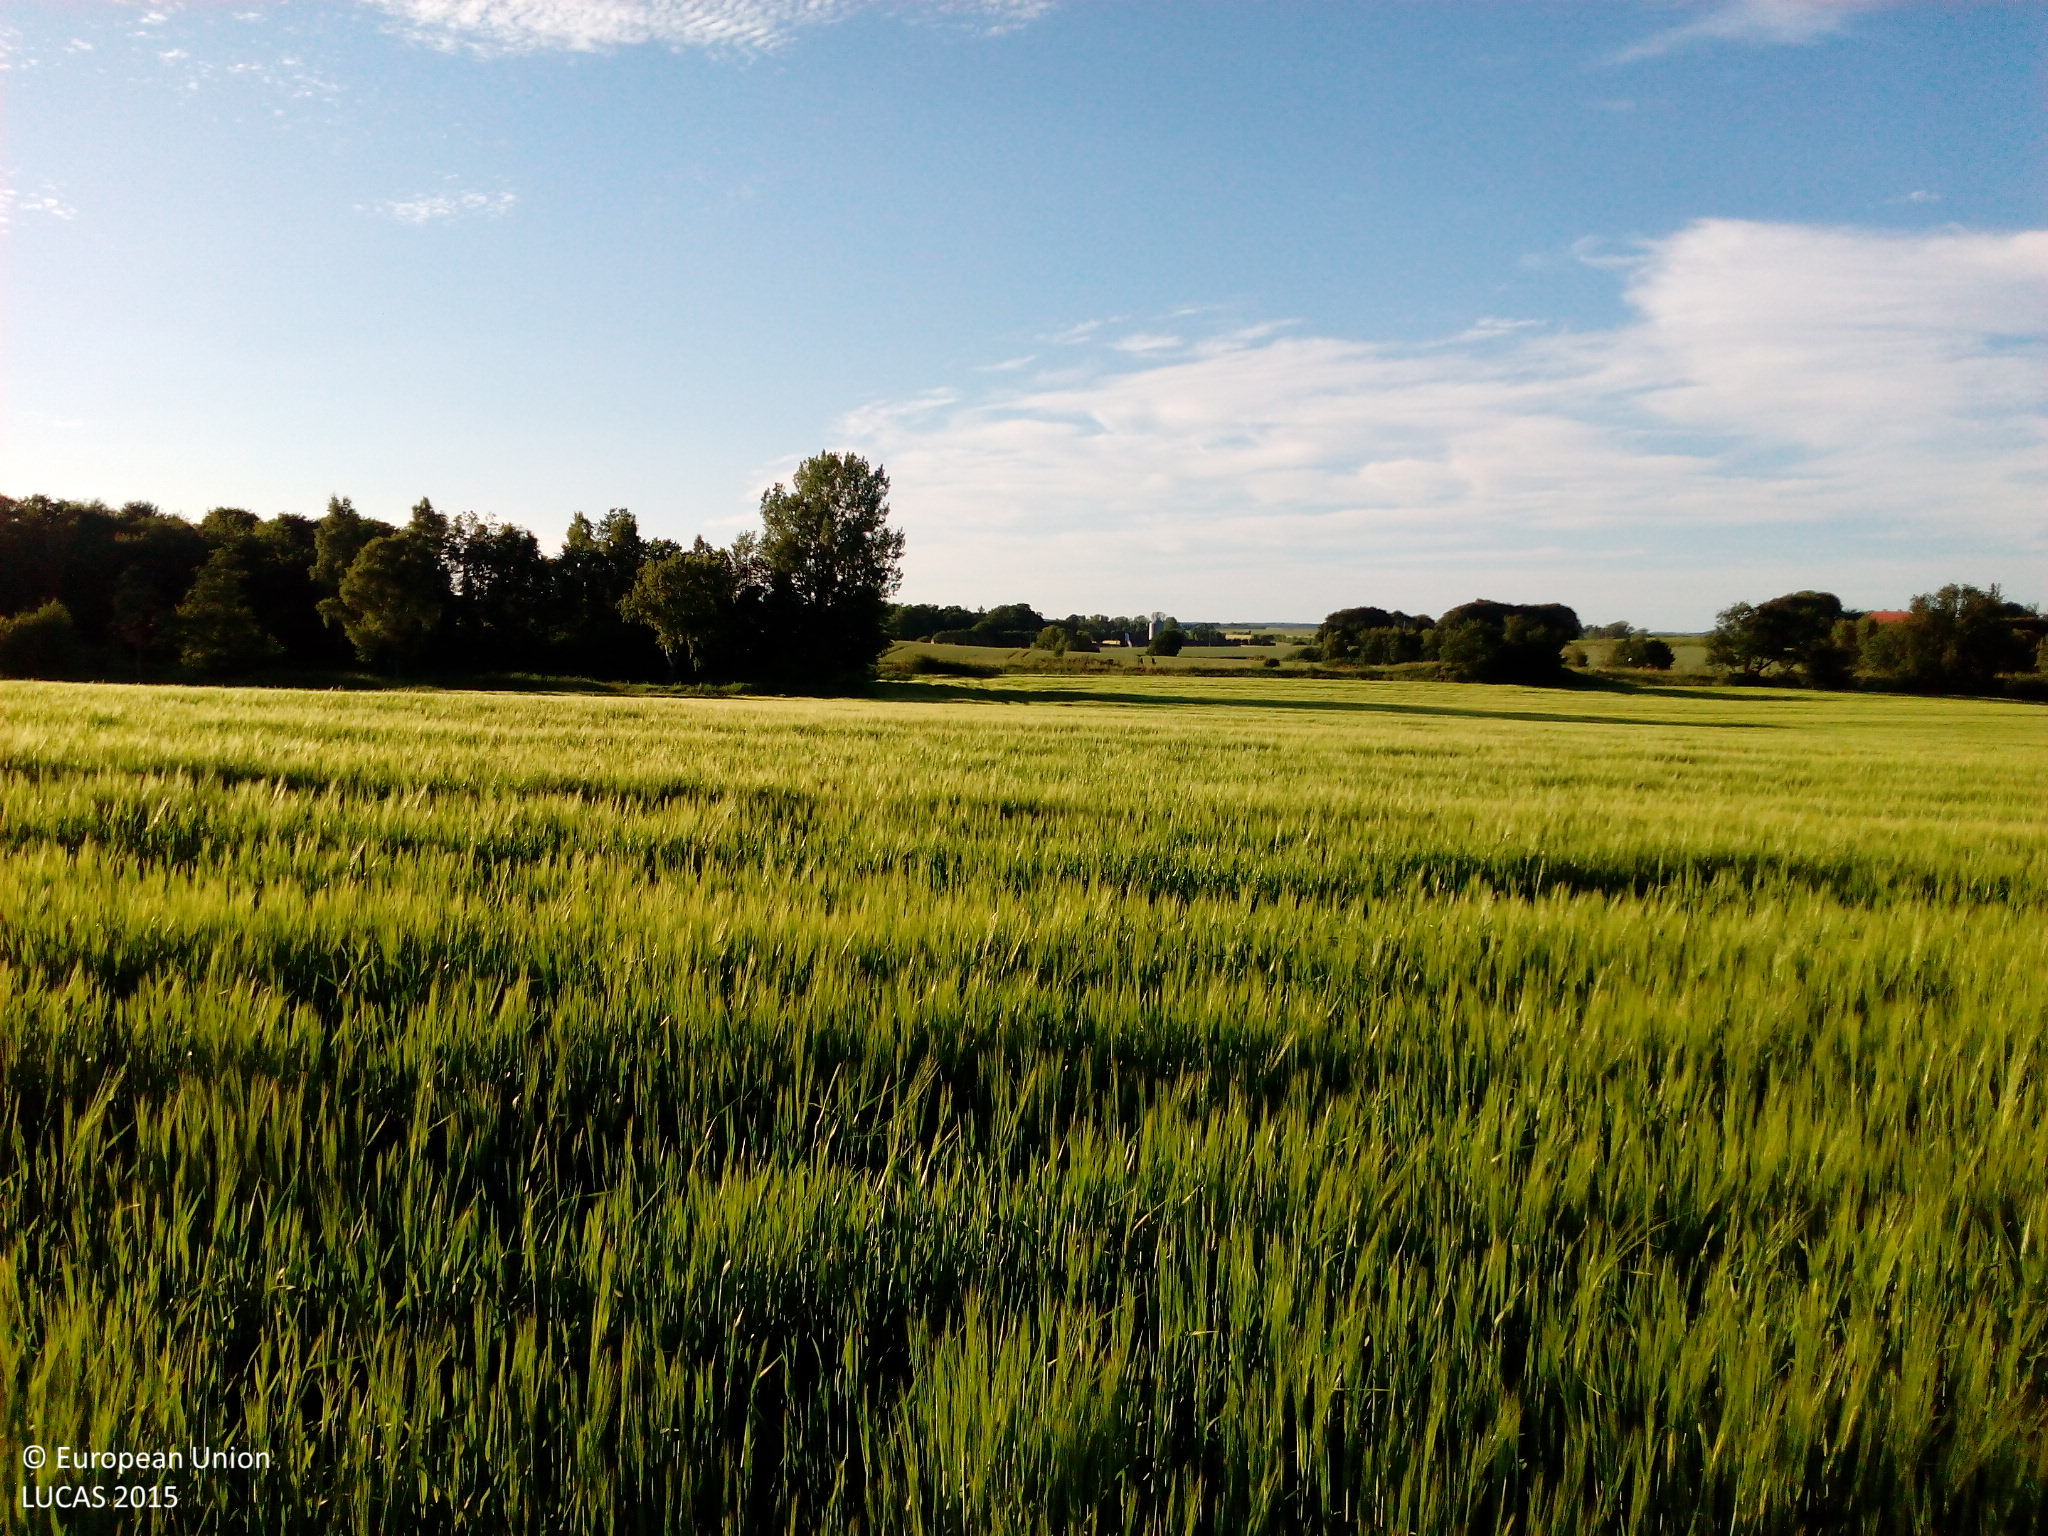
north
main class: Cropland
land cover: Triticale
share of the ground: > 75 %
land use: Agriculture (excluding fallow land and kitchen gardens)
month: June
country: DK
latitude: 56.3473
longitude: 10.7595
